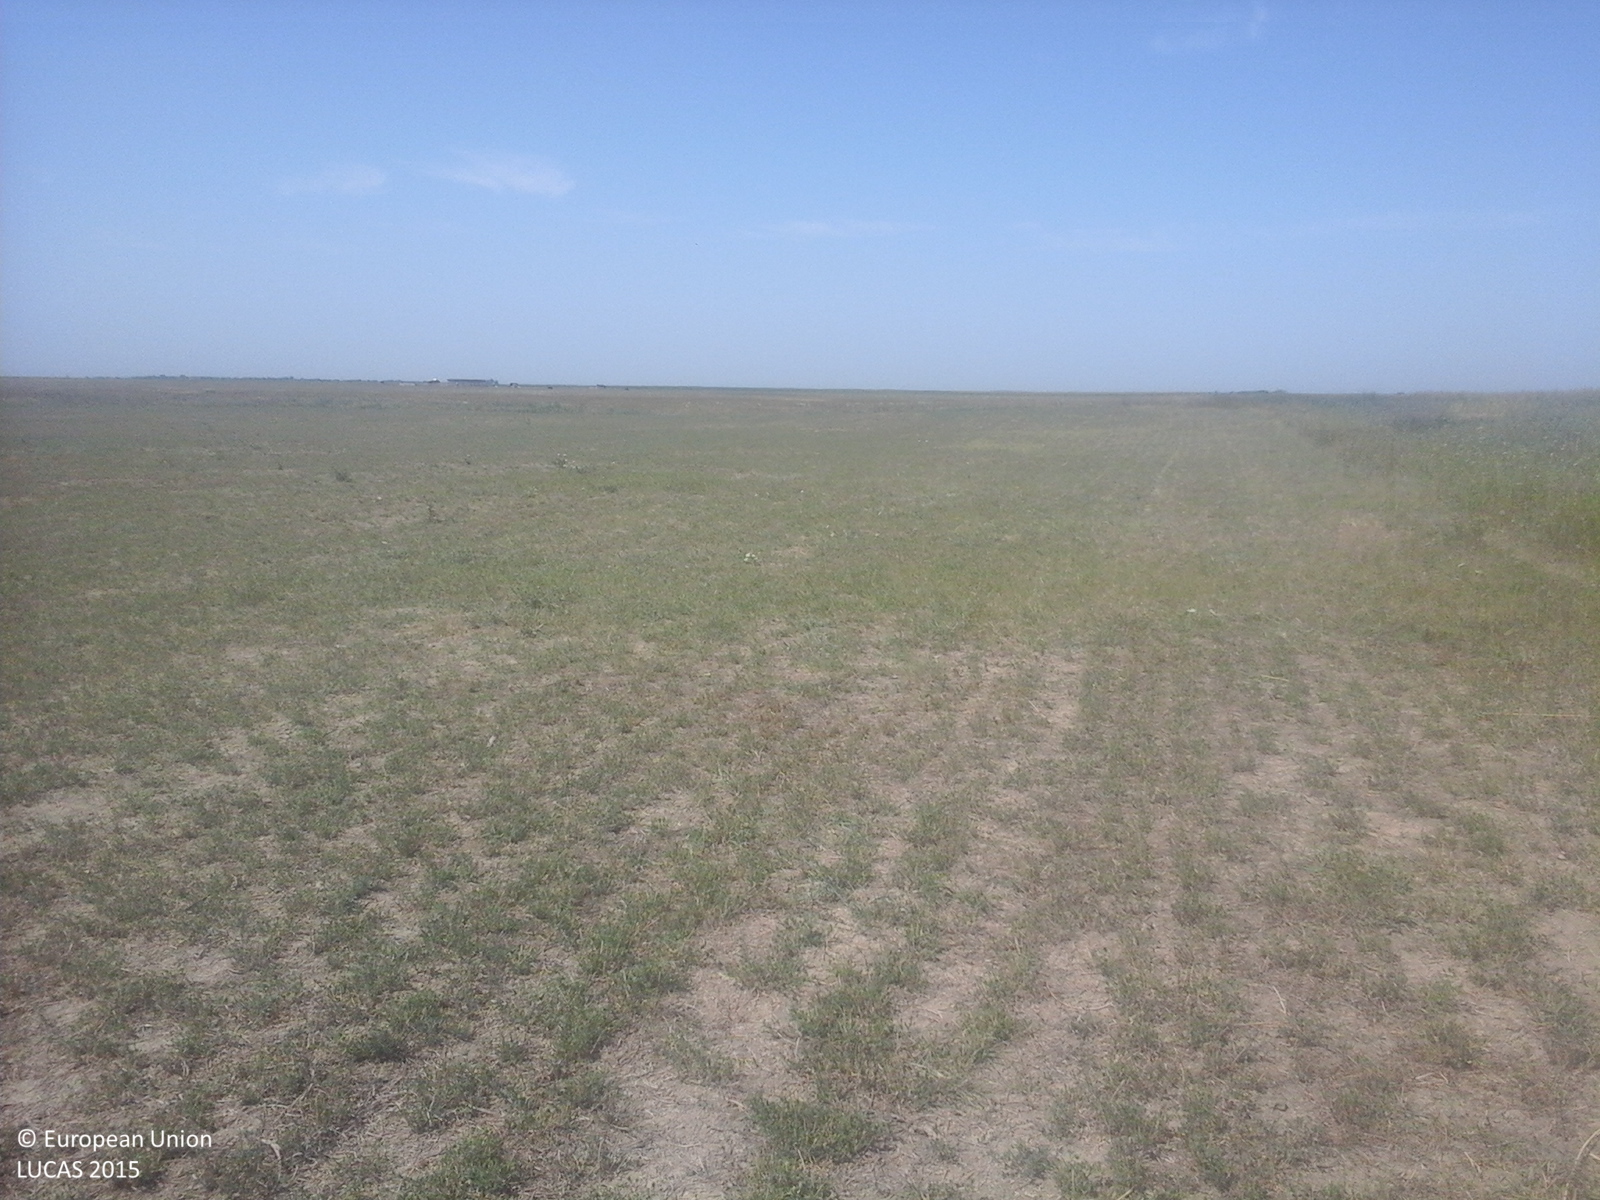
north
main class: Cropland
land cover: Lucerne
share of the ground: 50 - 75 %
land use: Agriculture (excluding fallow land and kitchen gardens)
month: August
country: RO
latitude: 45.5241
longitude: 27.4757
